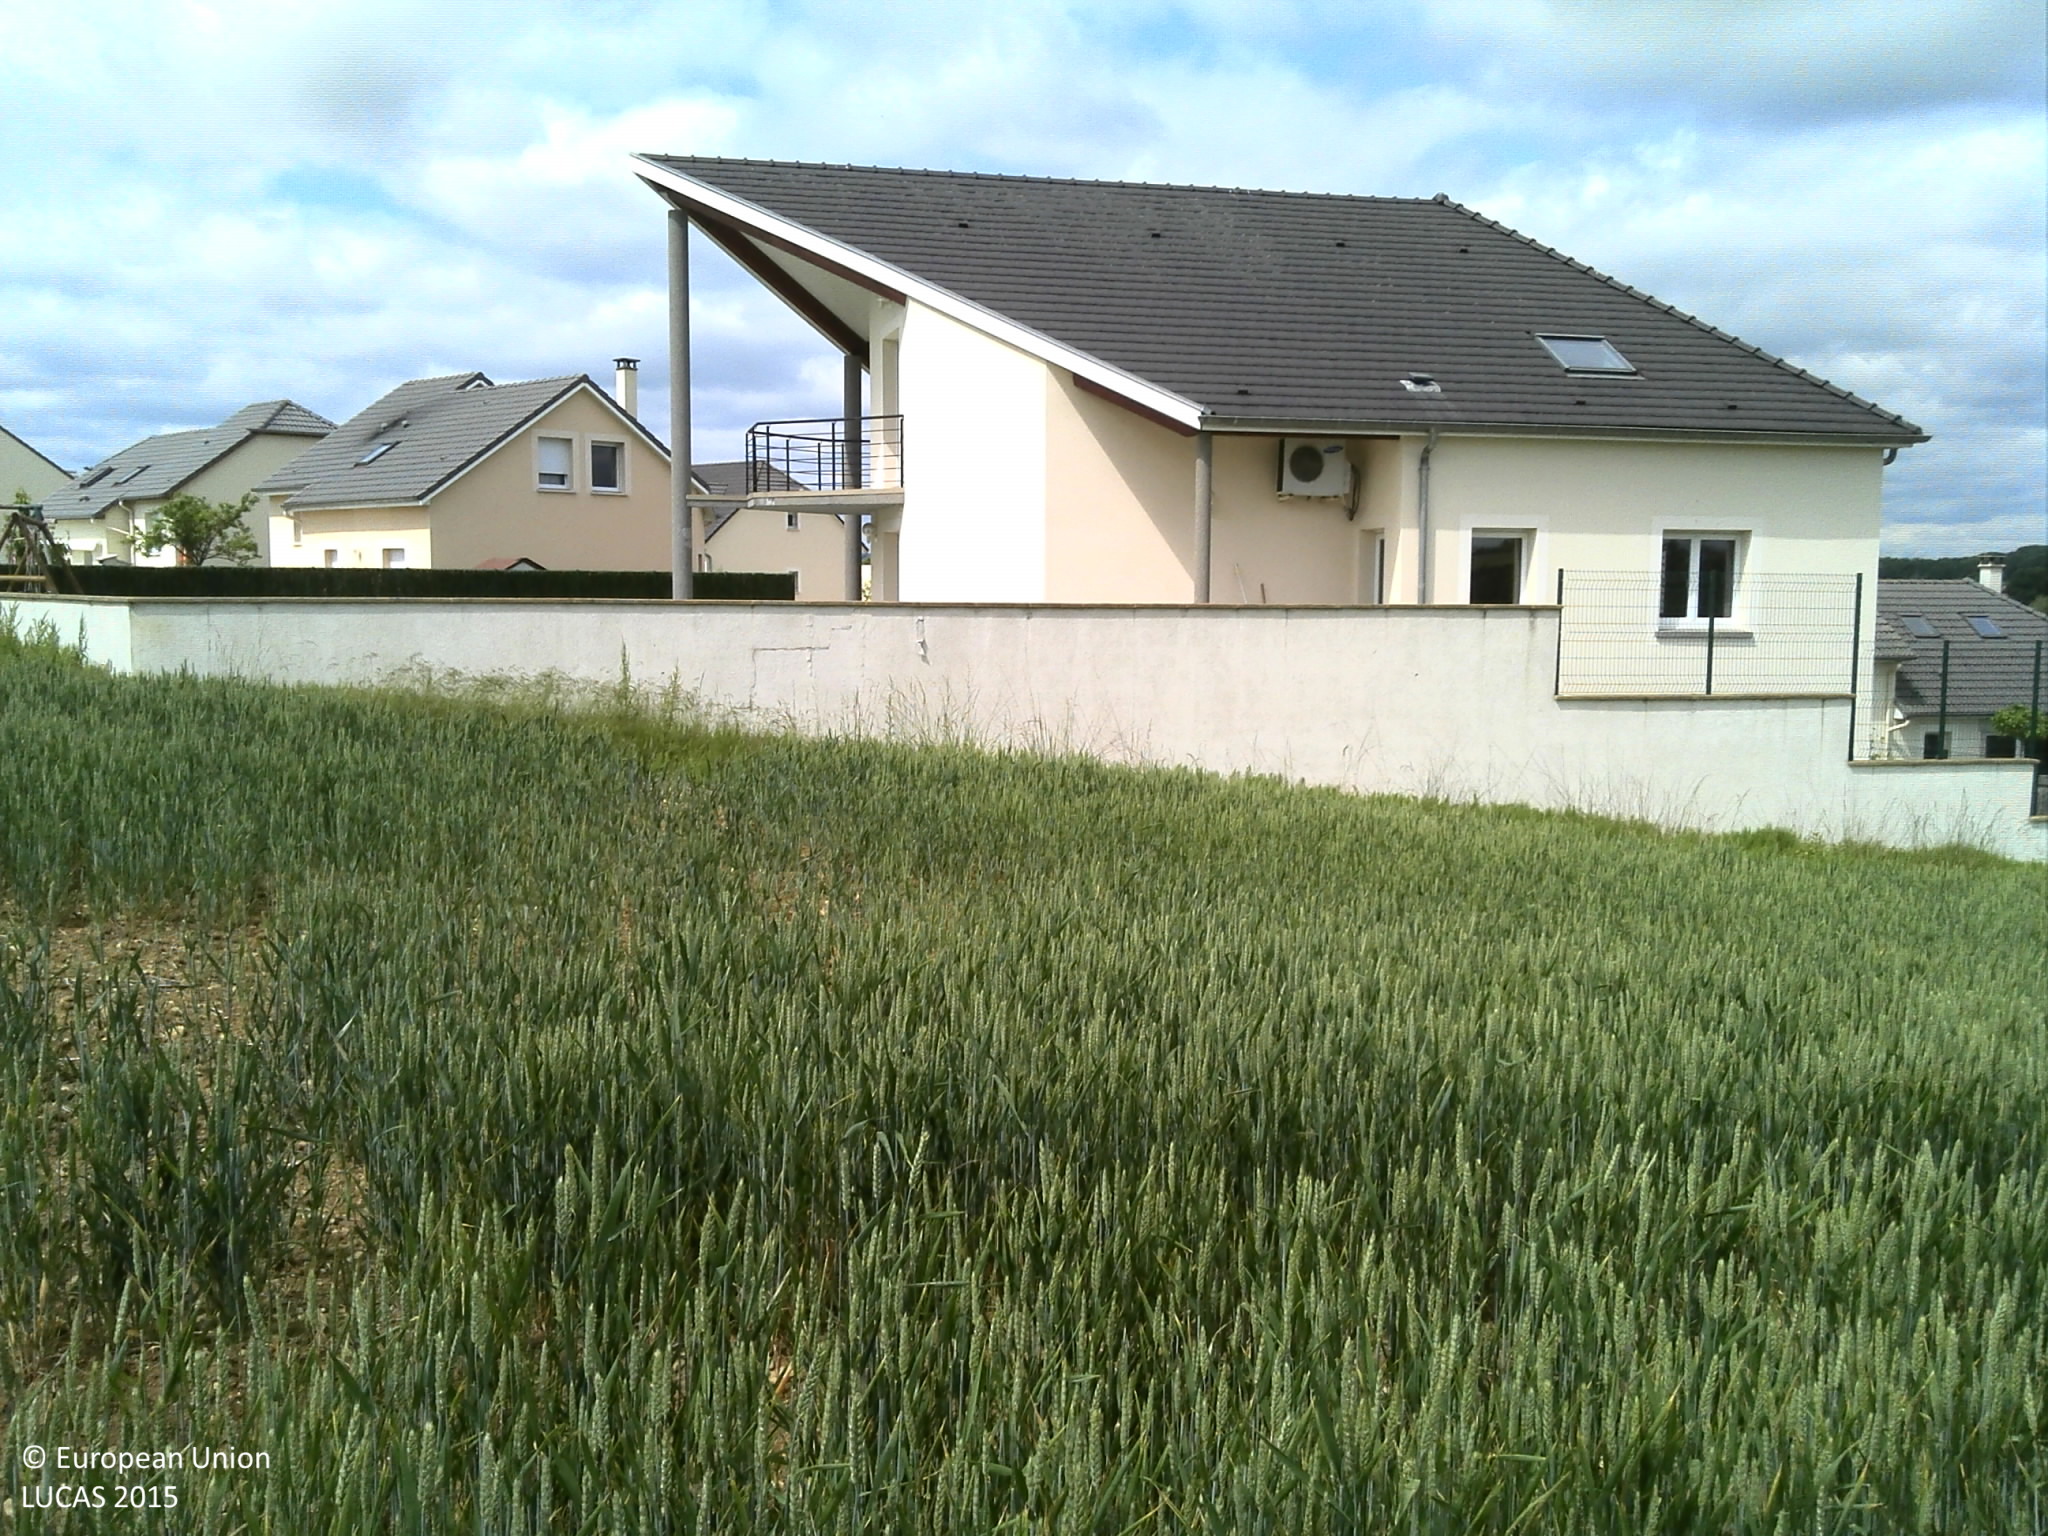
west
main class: Cropland
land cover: Common wheat
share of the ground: > 75 %
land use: Agriculture (excluding fallow land and kitchen gardens)
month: June
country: FR
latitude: 49.0051
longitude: 6.2132
